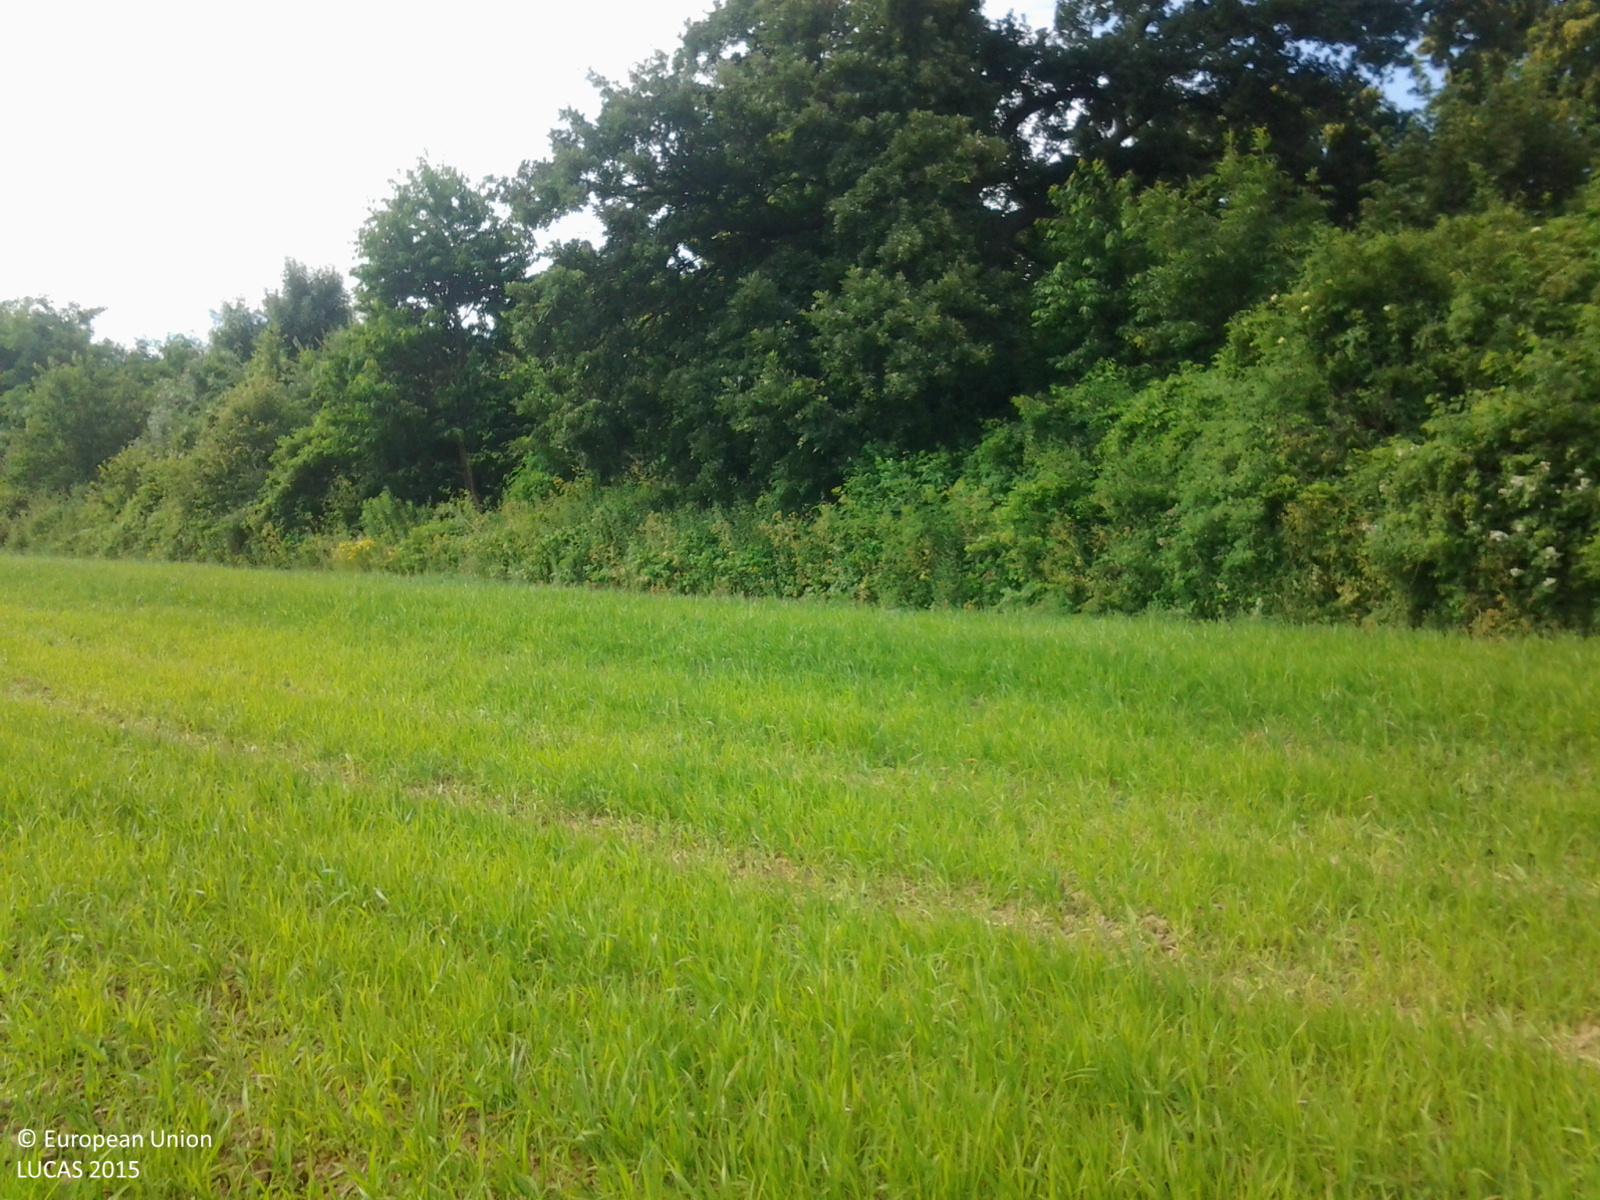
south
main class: Cropland
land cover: Common wheat
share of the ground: > 75 %
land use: Agriculture (excluding fallow land and kitchen gardens)
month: June
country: HU
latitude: 47.0692
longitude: 17.6847
